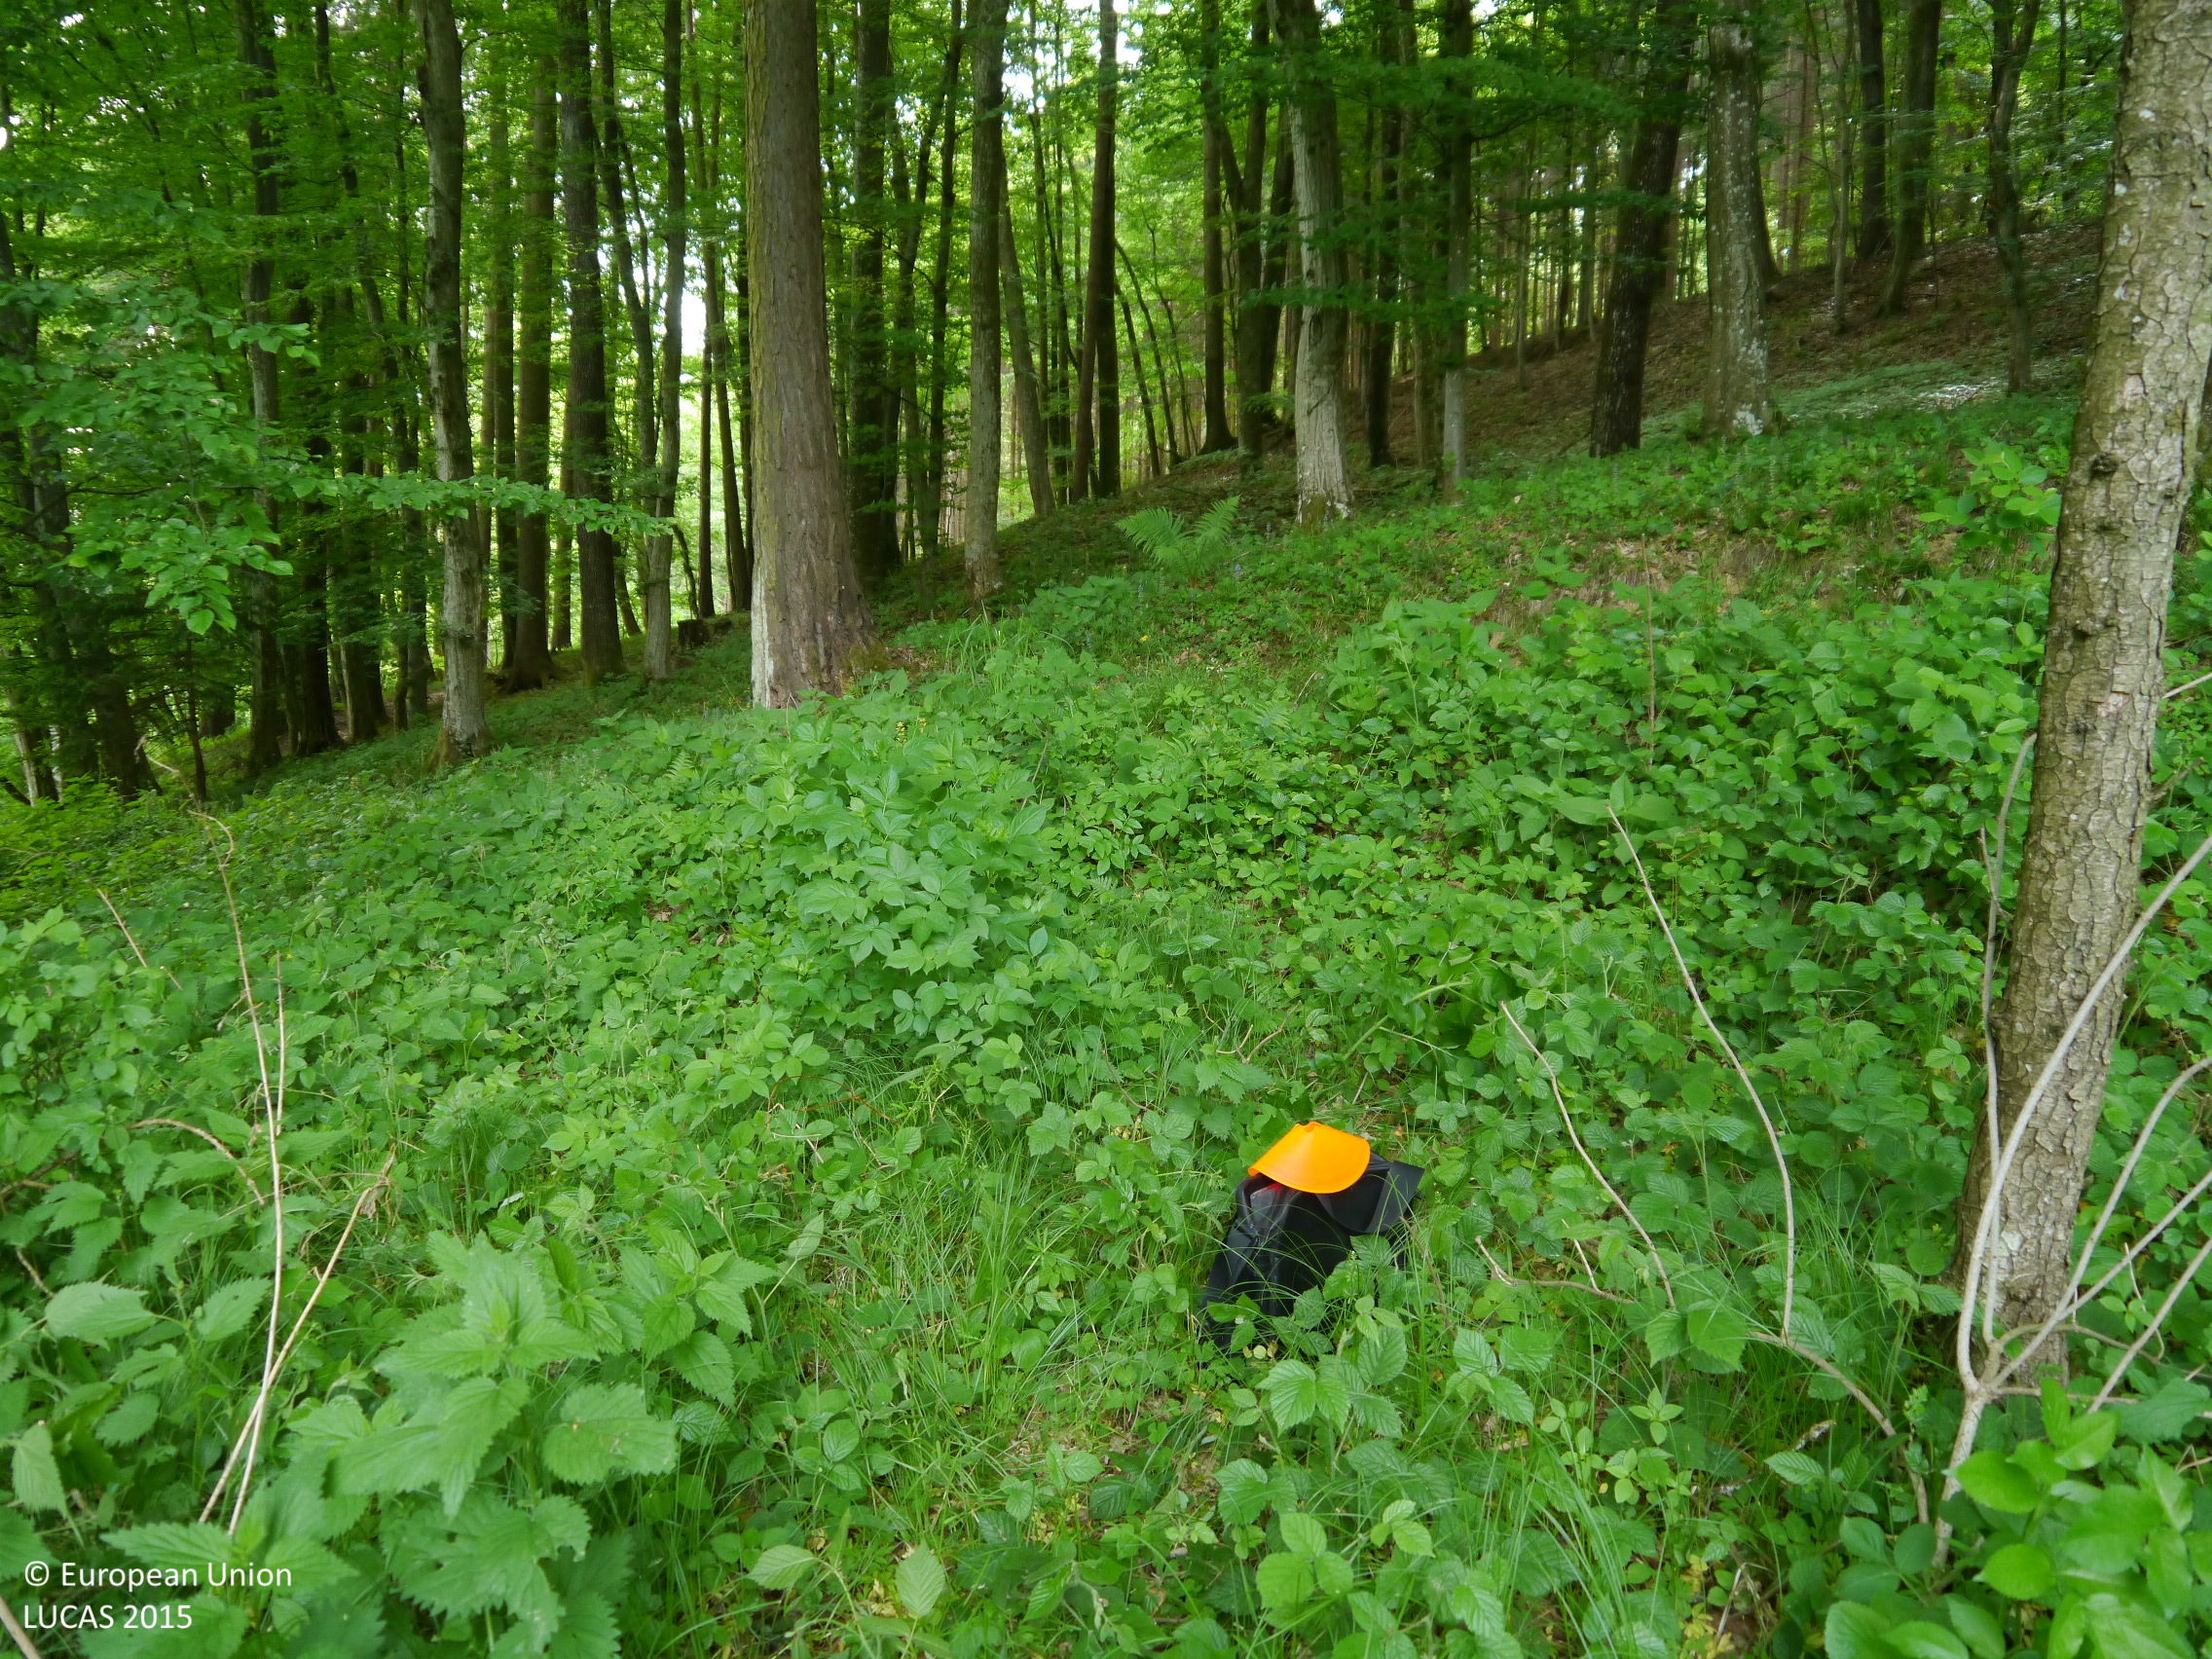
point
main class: Woodland
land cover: Broadleaved woodland
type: hemiboreal forest and nemoral coniferous forest and mixed broadleaved-coniferous forest
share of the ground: > 75 %
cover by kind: broadleaved forest trees 80 %, herbaceous plants 20 %
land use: Forestry
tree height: > 5 m
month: May
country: AT
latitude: 46.9745
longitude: 15.7183
